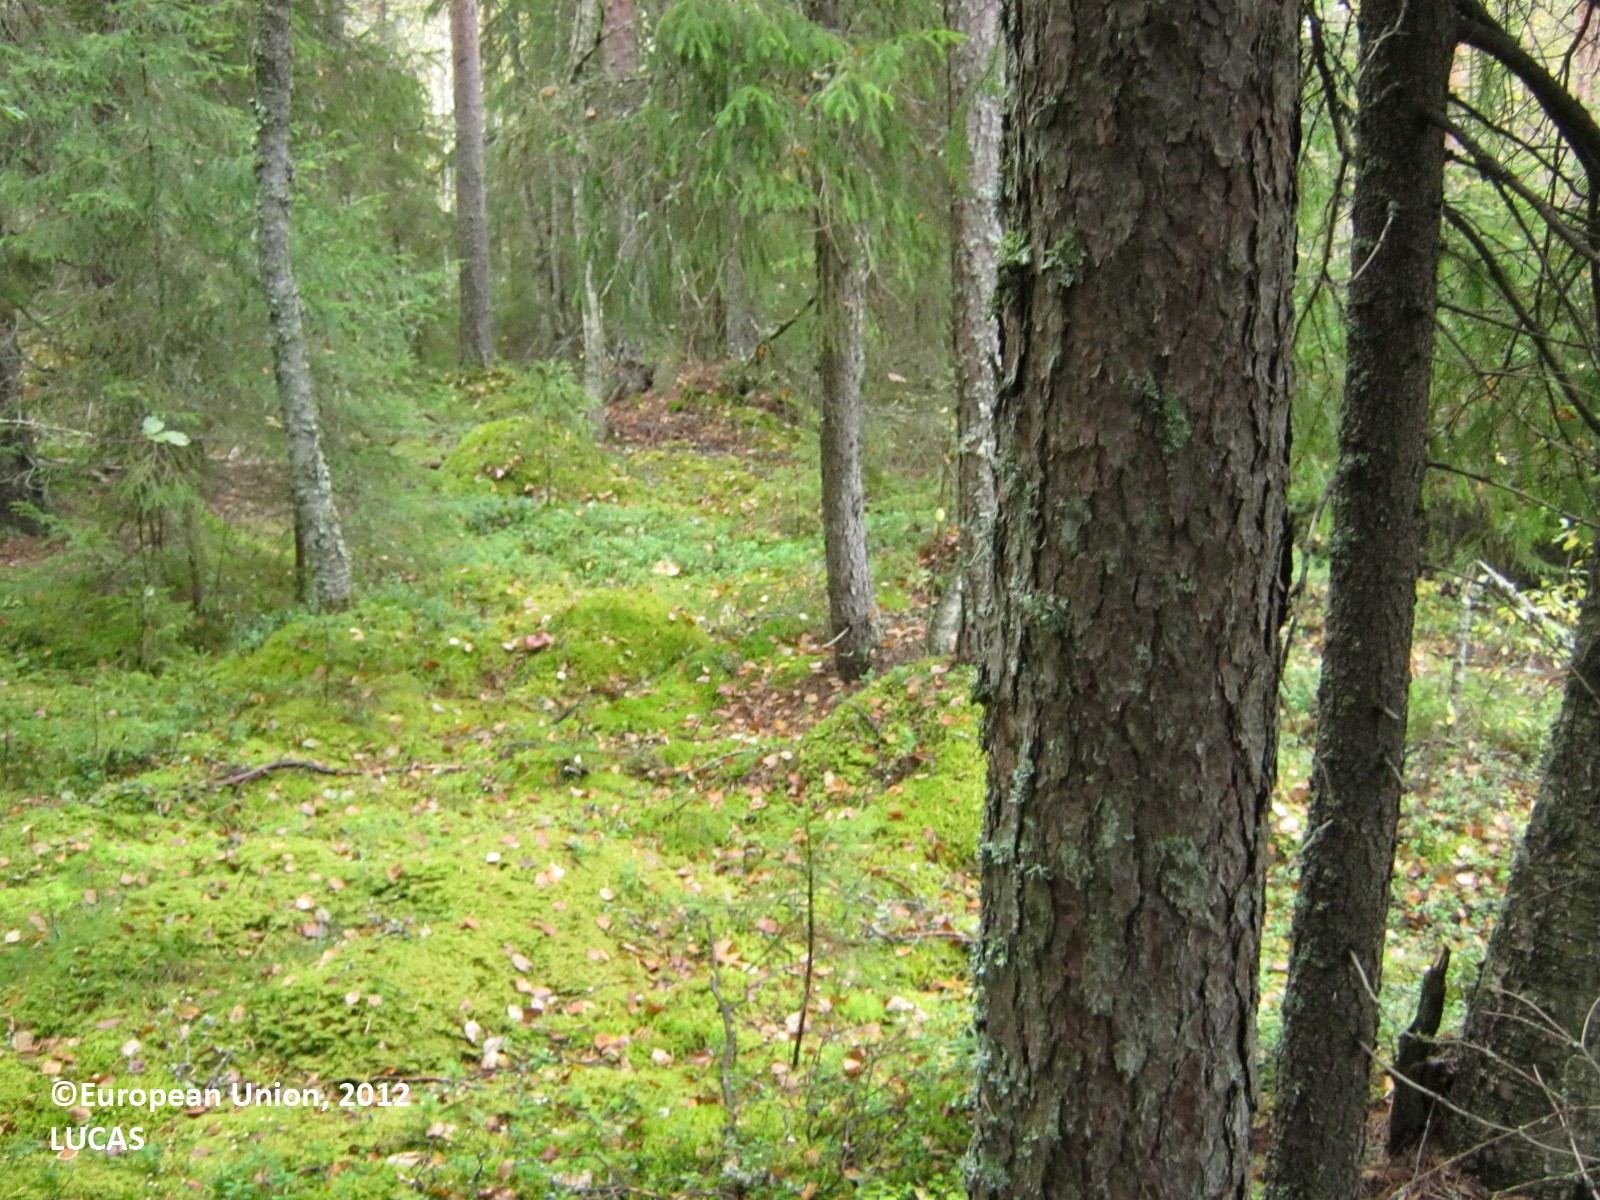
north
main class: Woodland
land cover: Spruce dominated coniferous woodland
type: boreal forest
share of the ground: 50 - 75 %
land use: Forestry
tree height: > 5 m
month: September
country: FI
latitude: 60.8808
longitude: 27.5570
